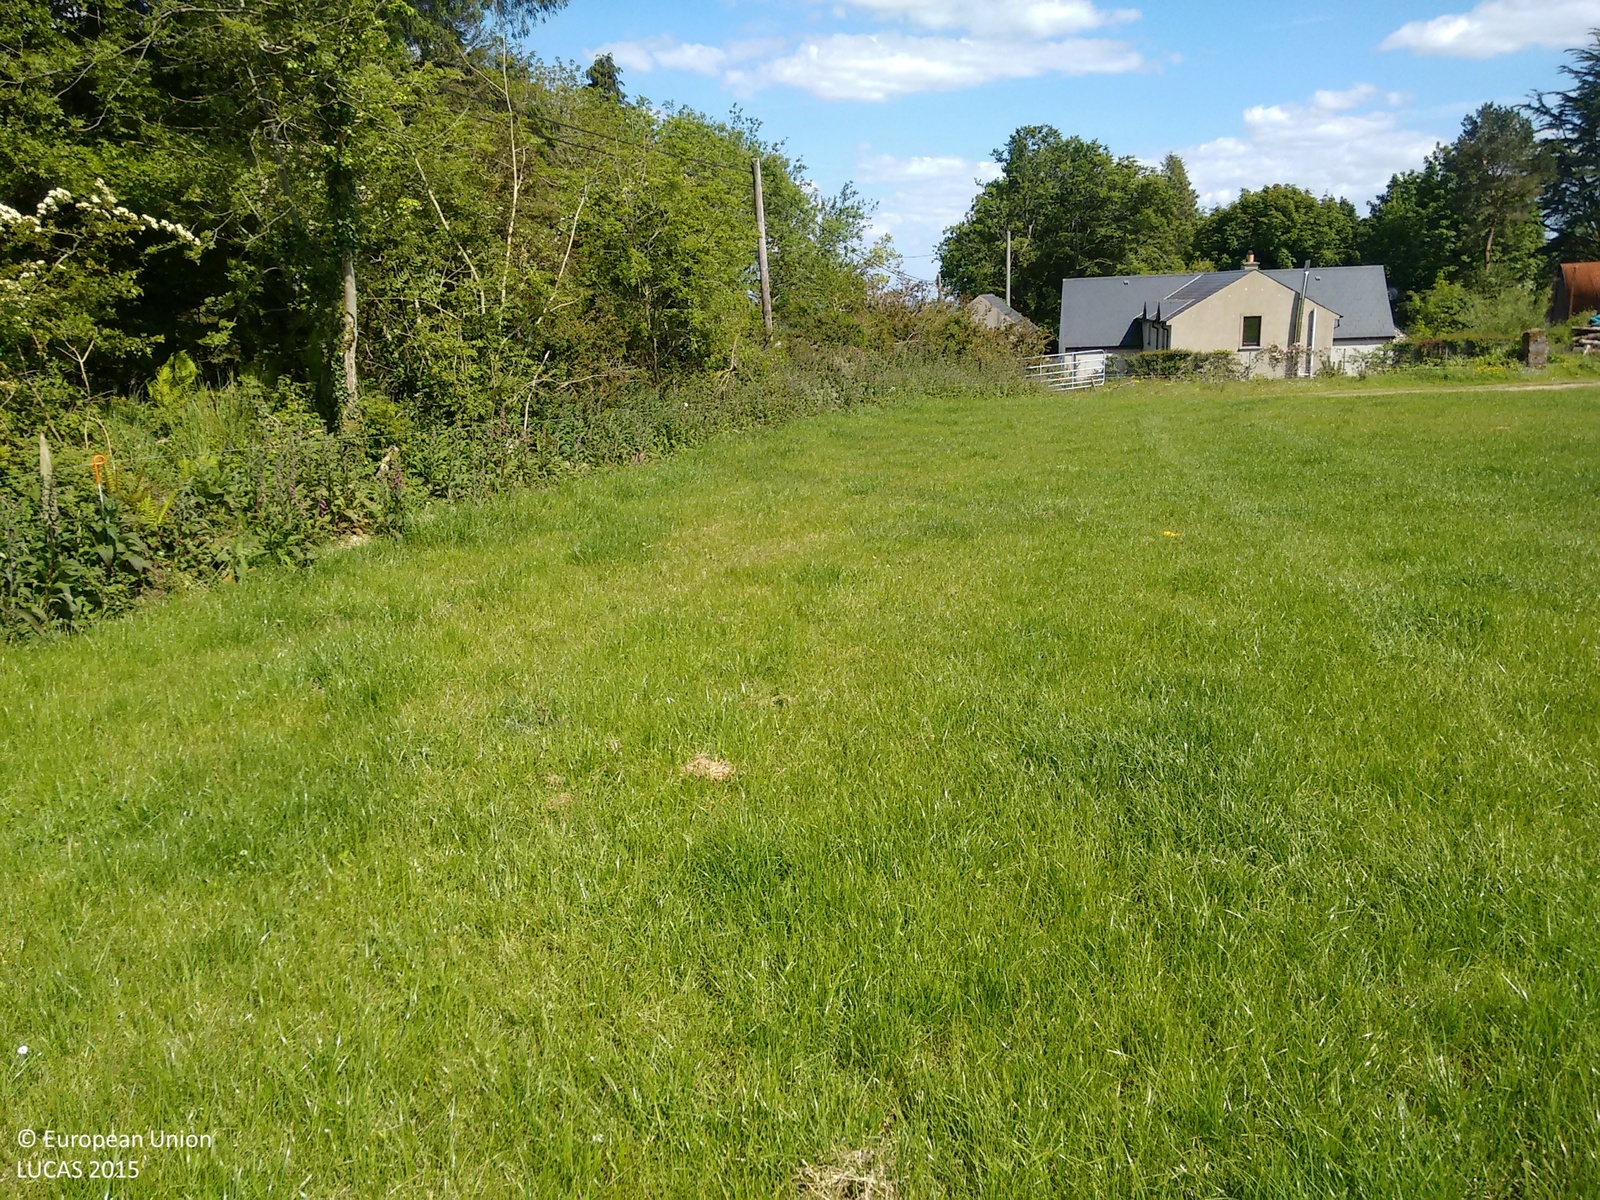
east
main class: Grassland
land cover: Grassland without tree/shrub cover
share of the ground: > 75 %
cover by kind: herbaceous plants 95 %, shrubs 5 %
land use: Agriculture (excluding fallow land and kitchen gardens)
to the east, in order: Grassland without tree/shrub cover; Fences; Shruby margins; Broadleaved woodland; Dry stone walls; Electric lines; Grass margins; Paved roads, cycling and walking lanes; Dry stone walls; Spruce dominated coniferous woodland; Lines of trees; Tracks; Fences; Grassland without tree/shrub cover; Shrubland without tree cover; Artificial constructions in urban areas
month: June
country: IE
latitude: 51.9911
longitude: -8.8628
